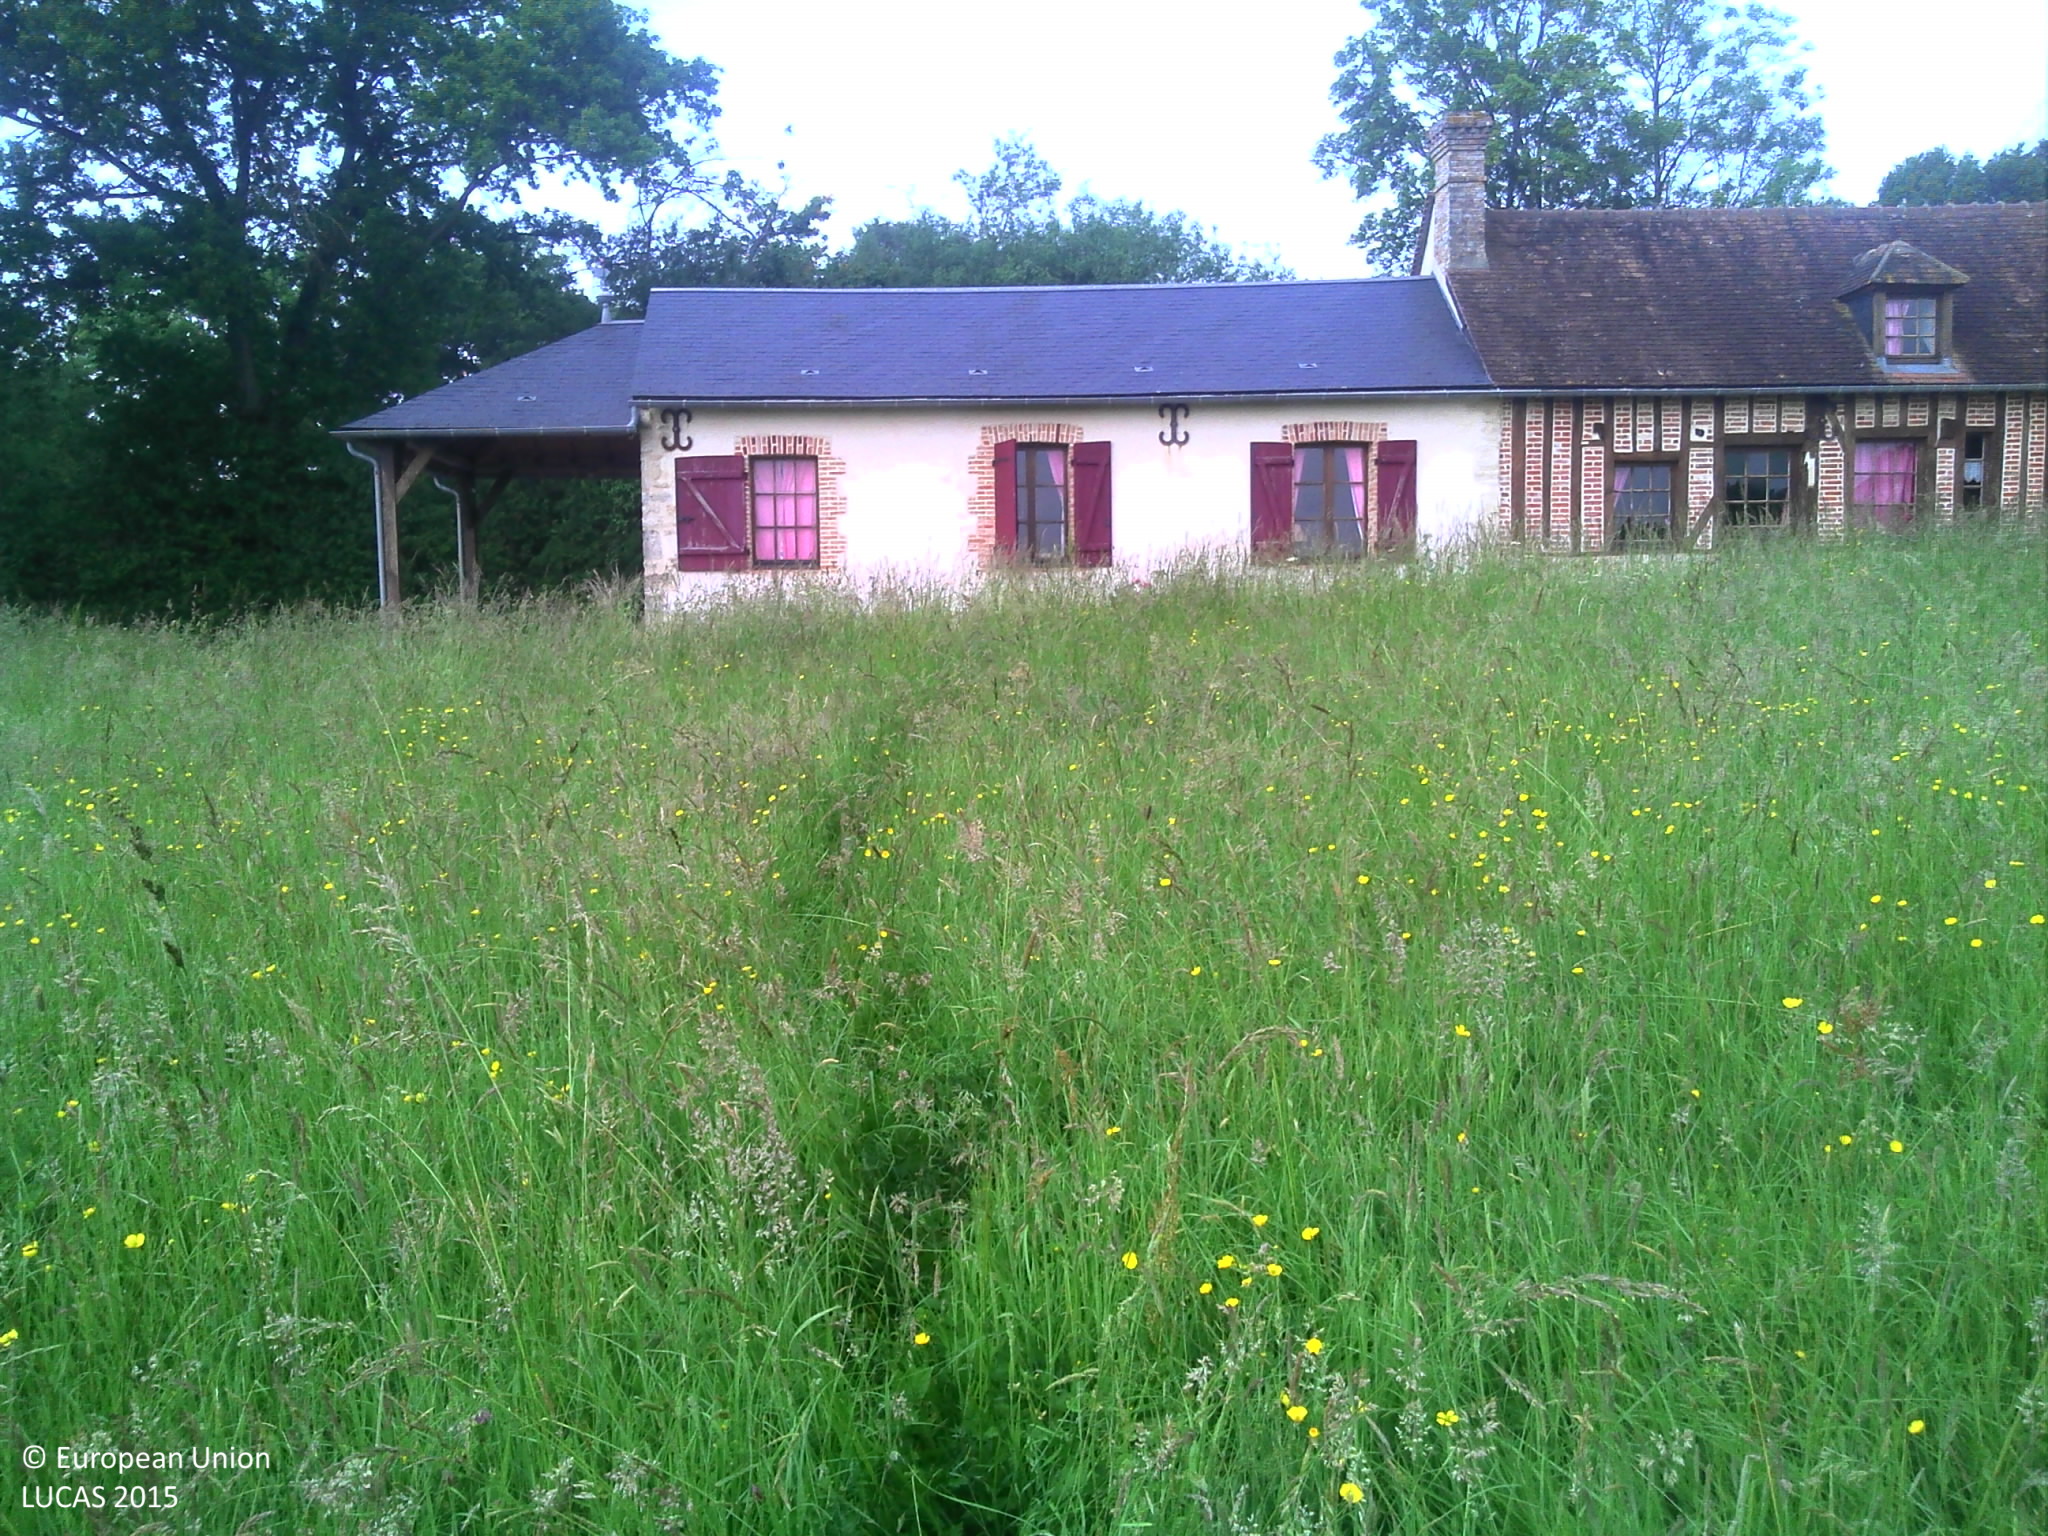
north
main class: Grassland
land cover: Grassland without tree/shrub cover
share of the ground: > 75 %
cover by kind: herbaceous plants 95 %
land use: Agriculture (excluding fallow land and kitchen gardens)
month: June
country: FR
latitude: 48.7055
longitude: 0.1467
